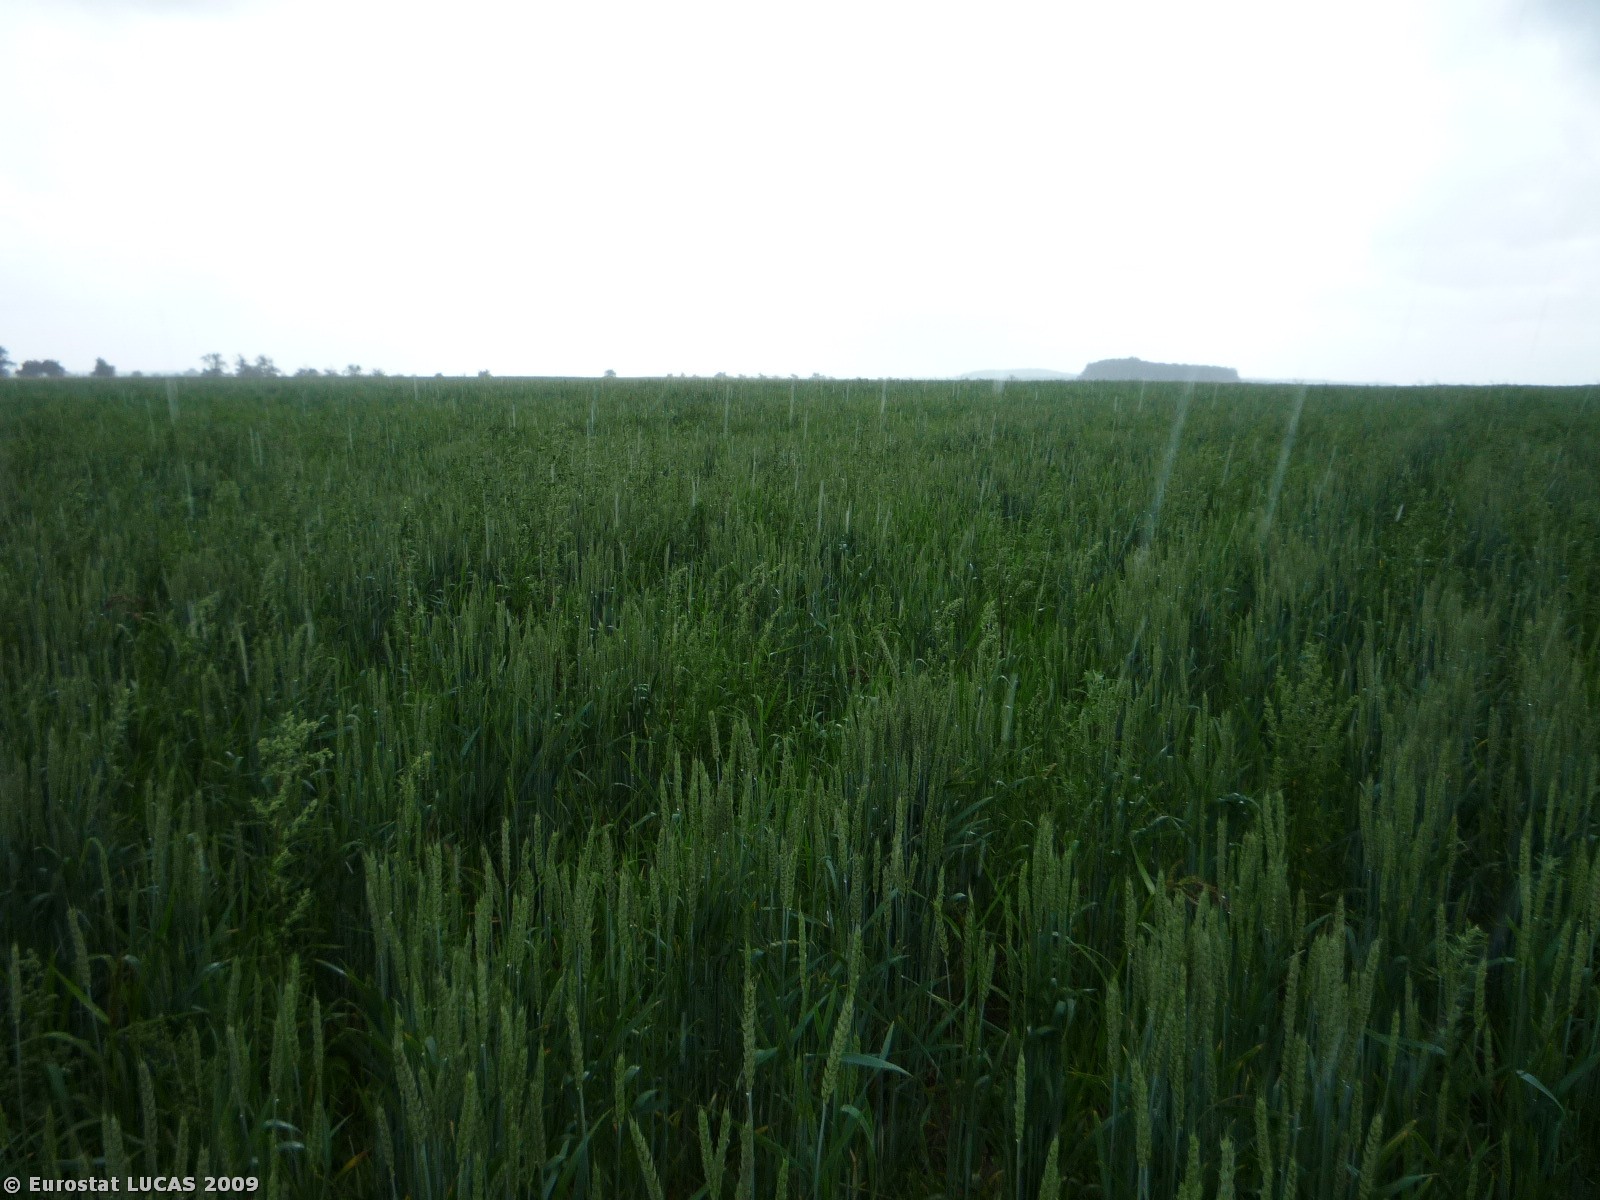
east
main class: Cropland
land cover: Common wheat
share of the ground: > 75 %
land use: Agriculture (excluding fallow land and kitchen gardens)
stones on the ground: < 10 %
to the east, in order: Common wheat; Grass margins; Common wheat
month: June
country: CZ
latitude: 50.1415
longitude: 15.5031
